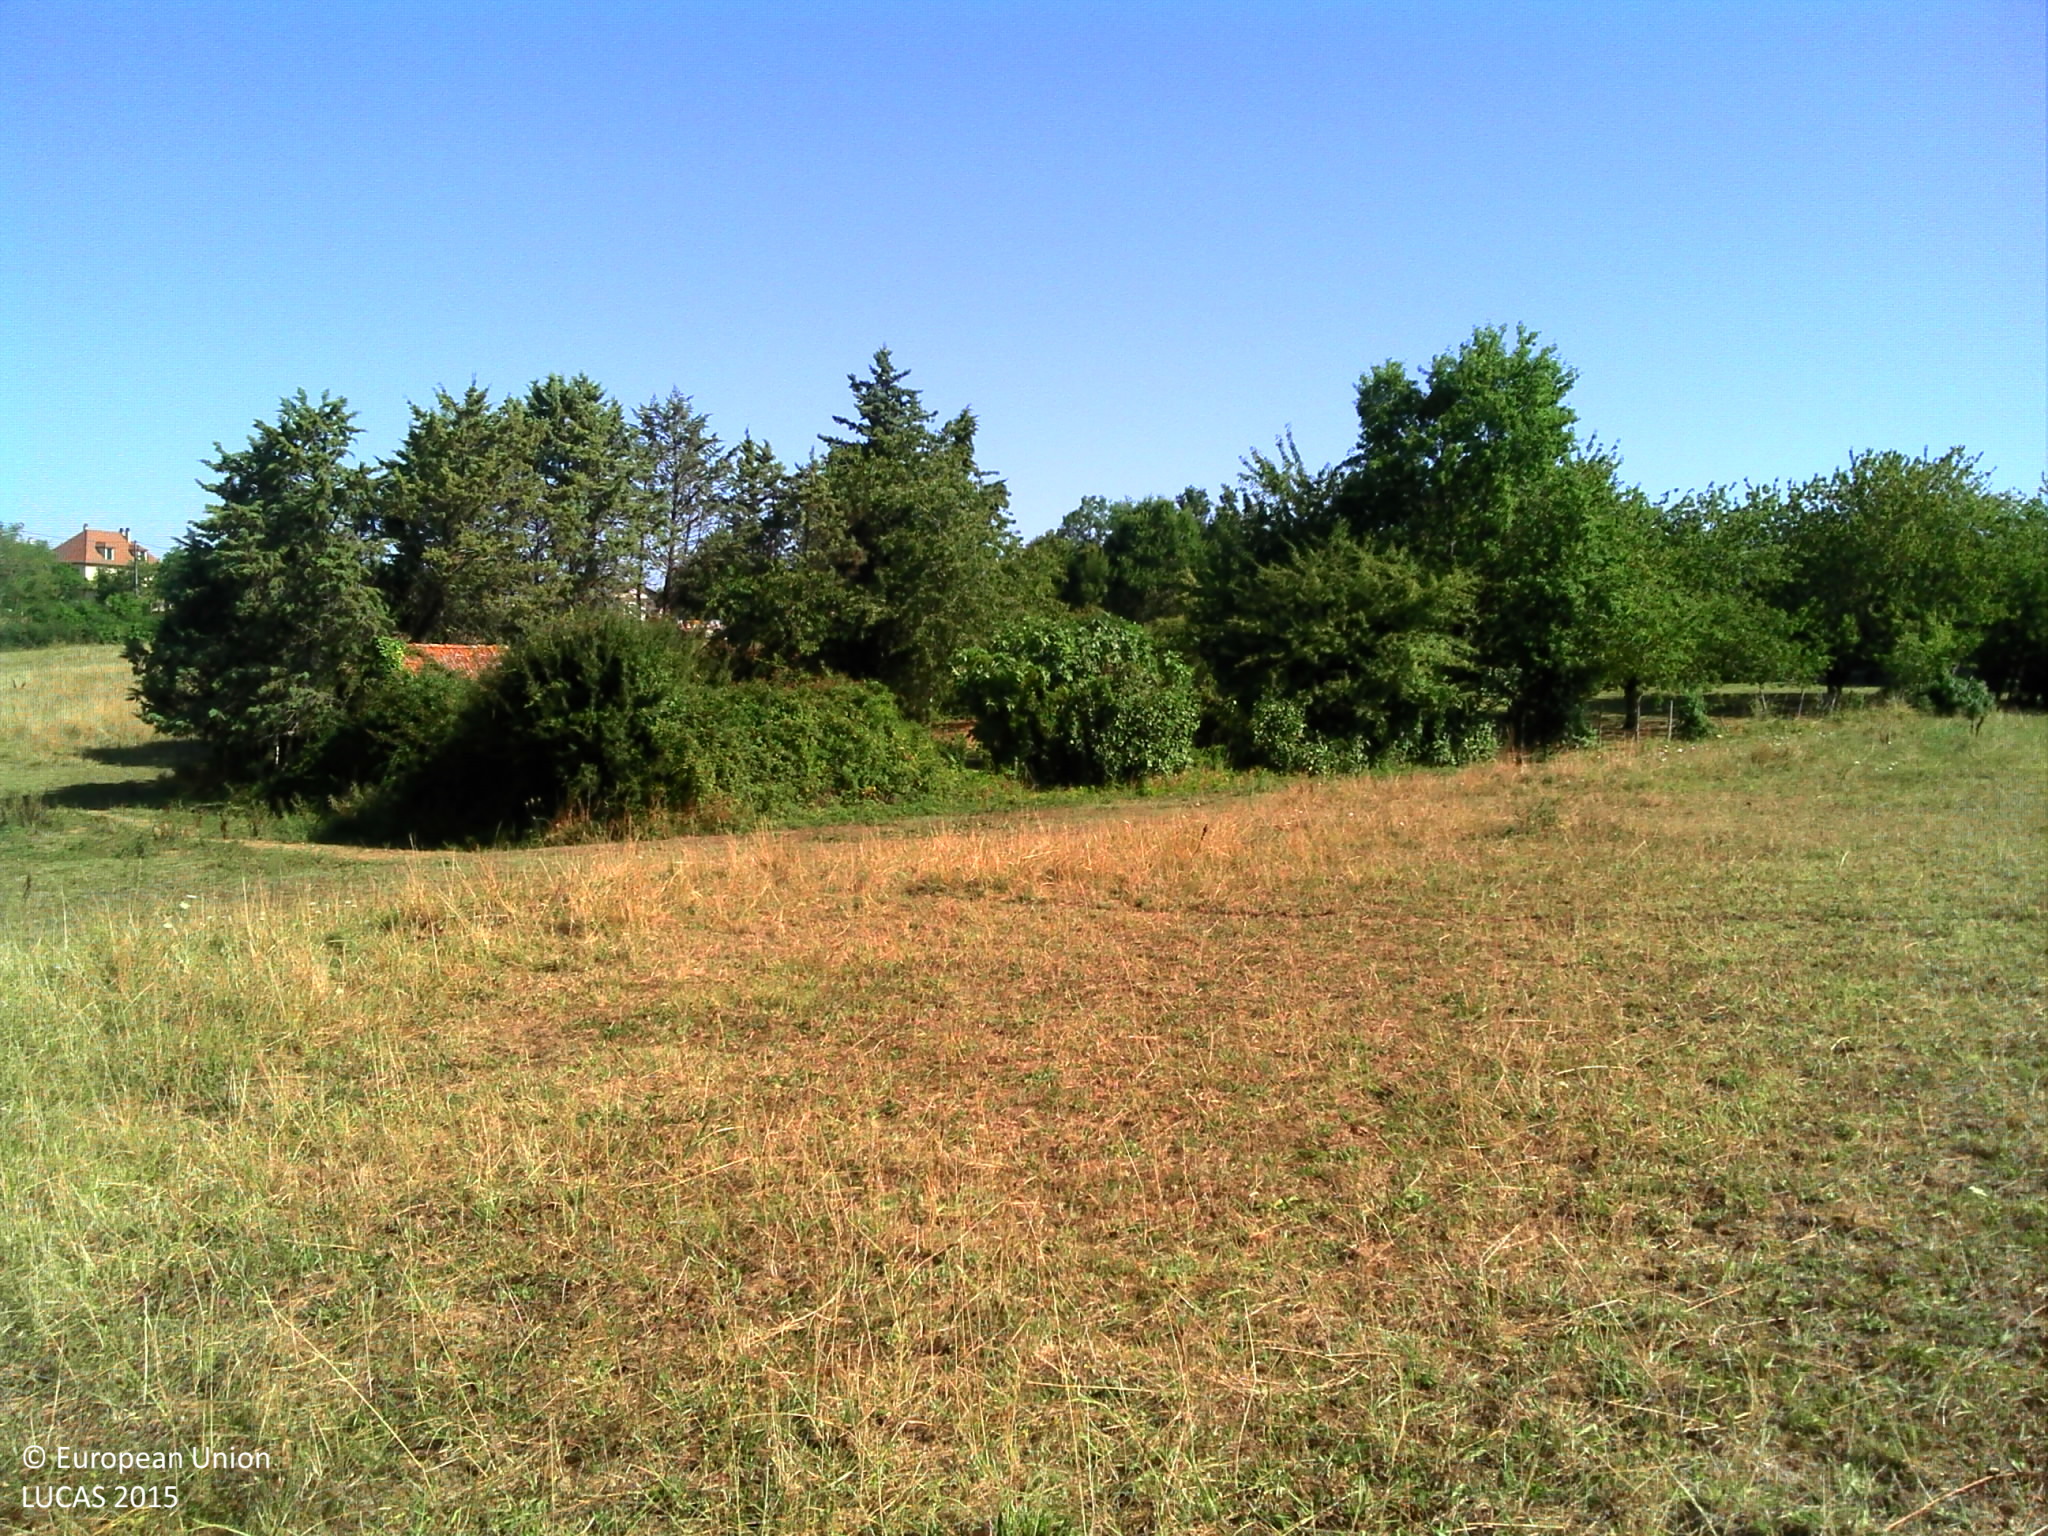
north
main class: Grassland
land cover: Grassland without tree/shrub cover
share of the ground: > 75 %
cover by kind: herbaceous plants 100 %
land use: Agriculture (excluding fallow land and kitchen gardens)
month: July
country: FR
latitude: 44.6487
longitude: 0.5983
